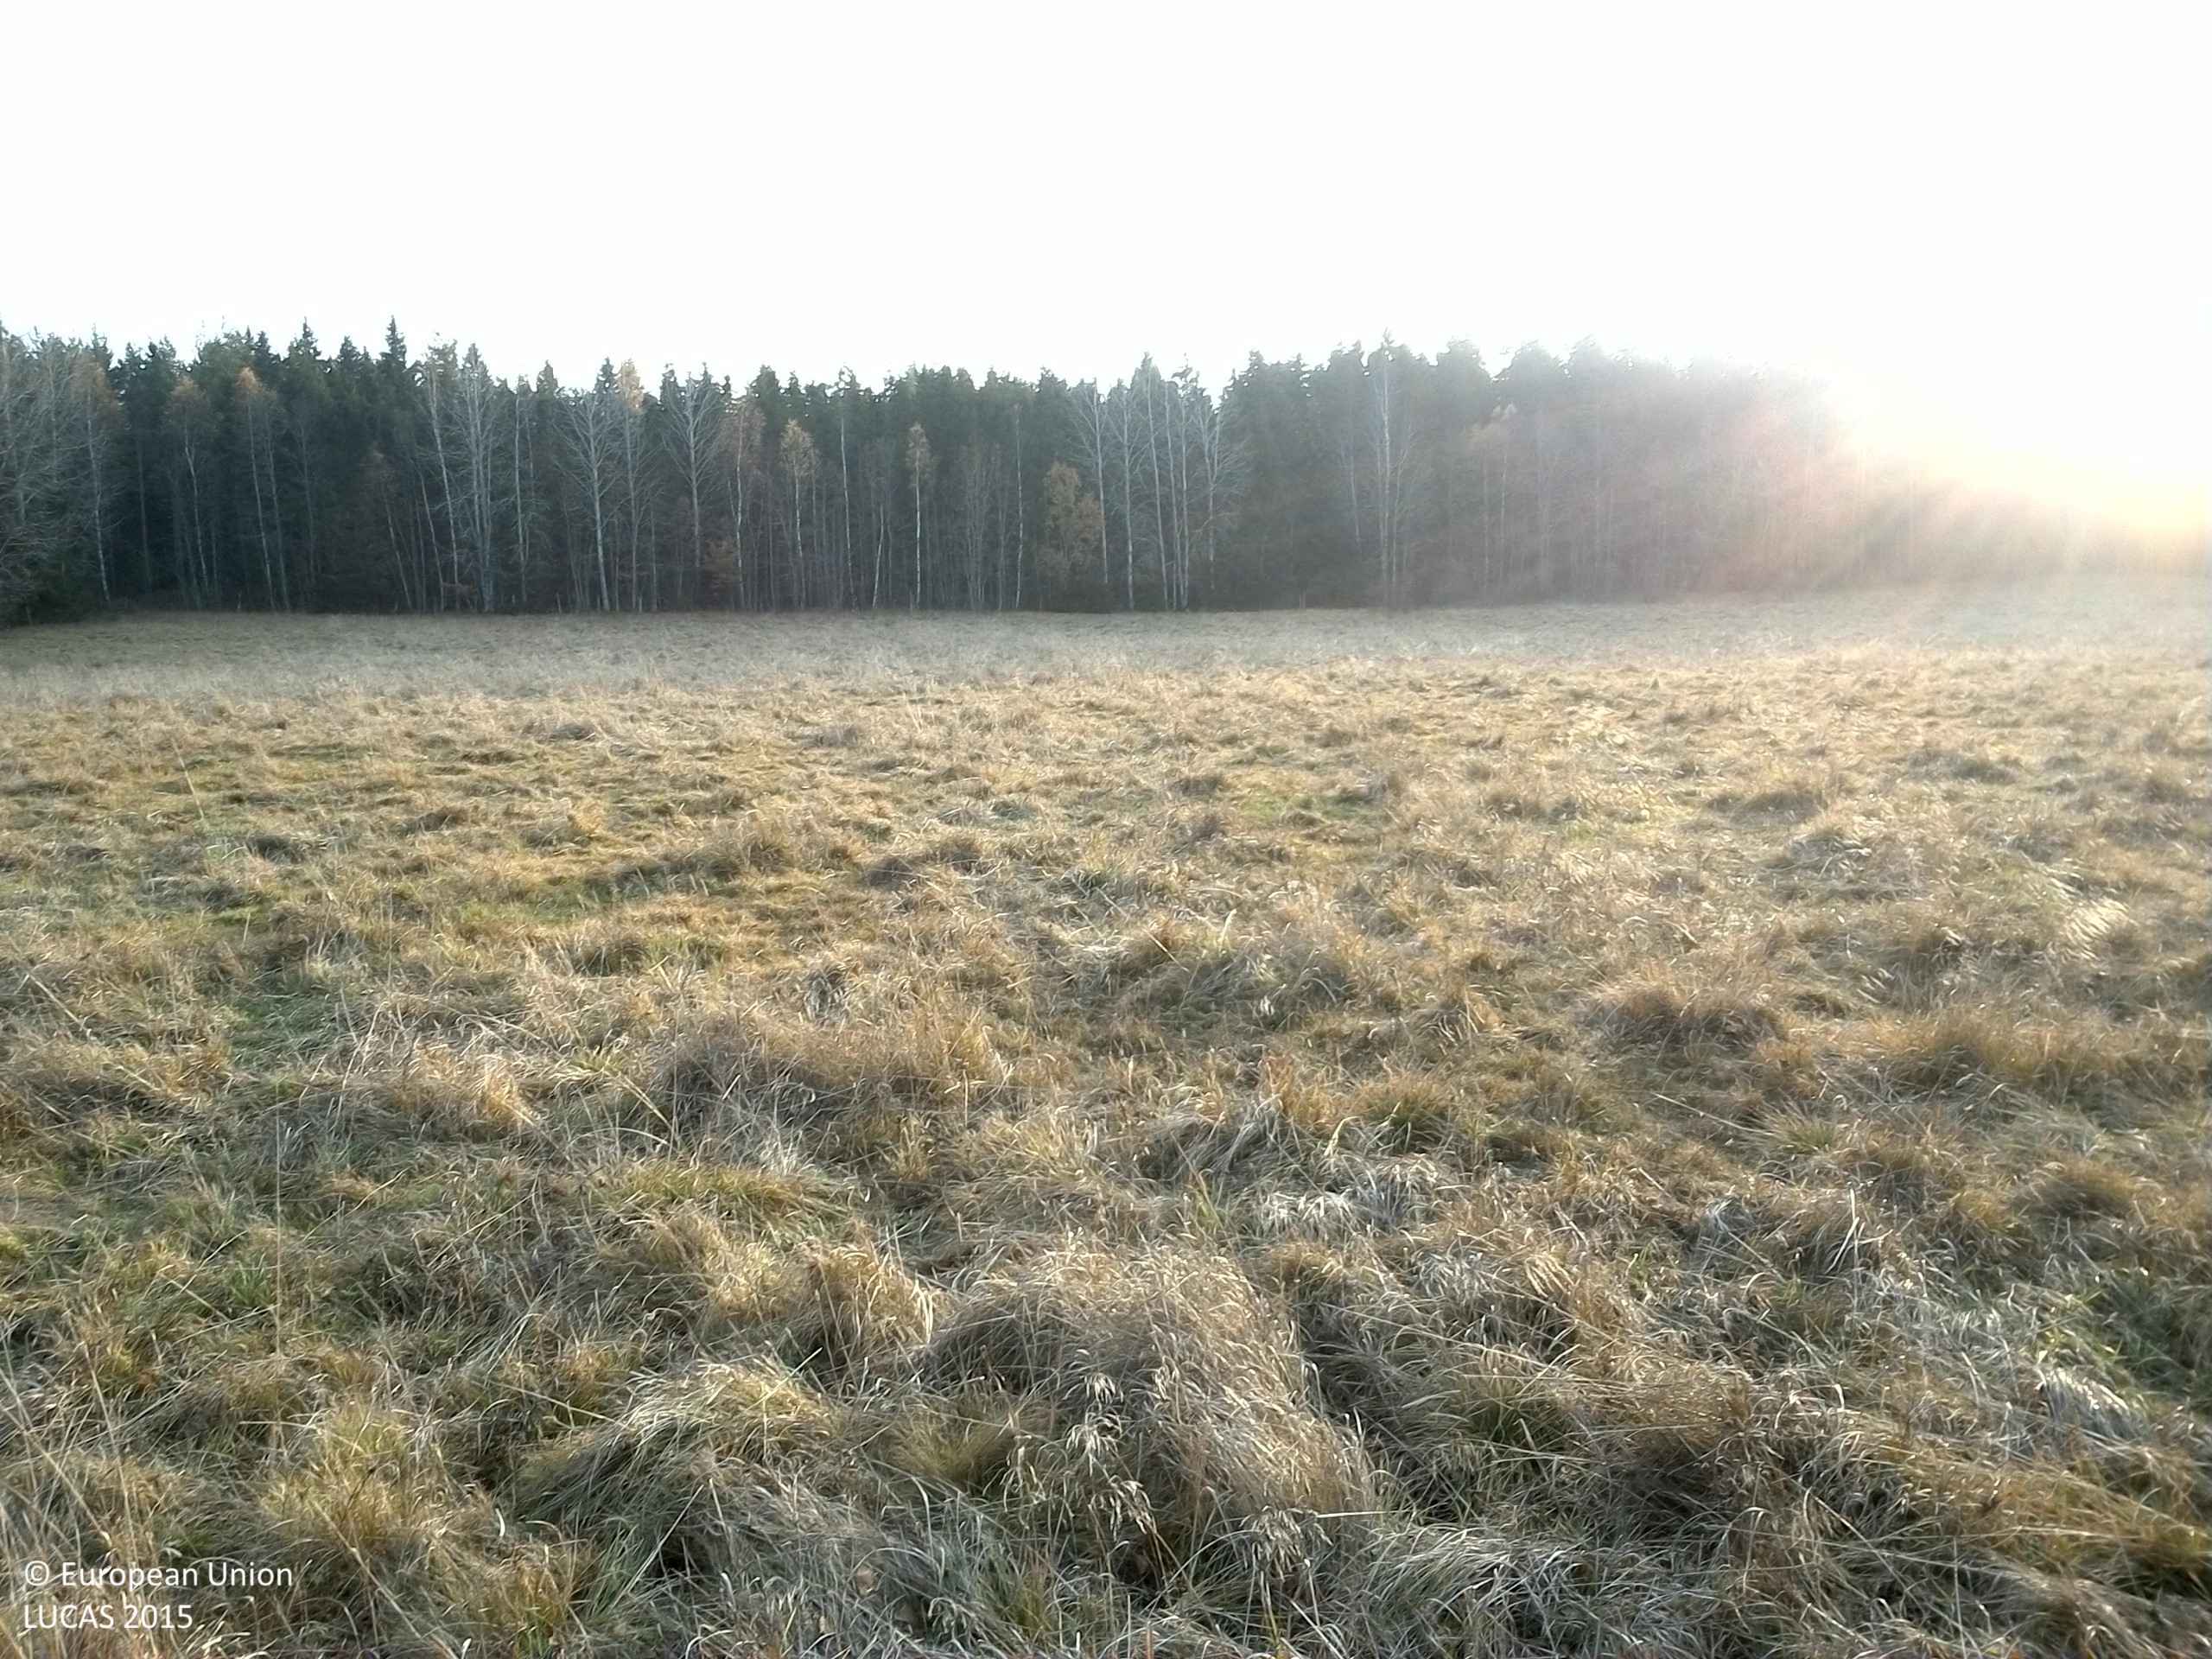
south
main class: Grassland
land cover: Grassland with sparse tree/shrub cover
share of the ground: > 75 %
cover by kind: herbaceous plants 90 %, broadleaved forest trees 5 %, shrubs 5 %
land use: Agriculture (excluding fallow land and kitchen gardens)
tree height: > 5 m
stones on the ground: < 10 %
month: October
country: SE
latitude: 59.2409
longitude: 17.1300
